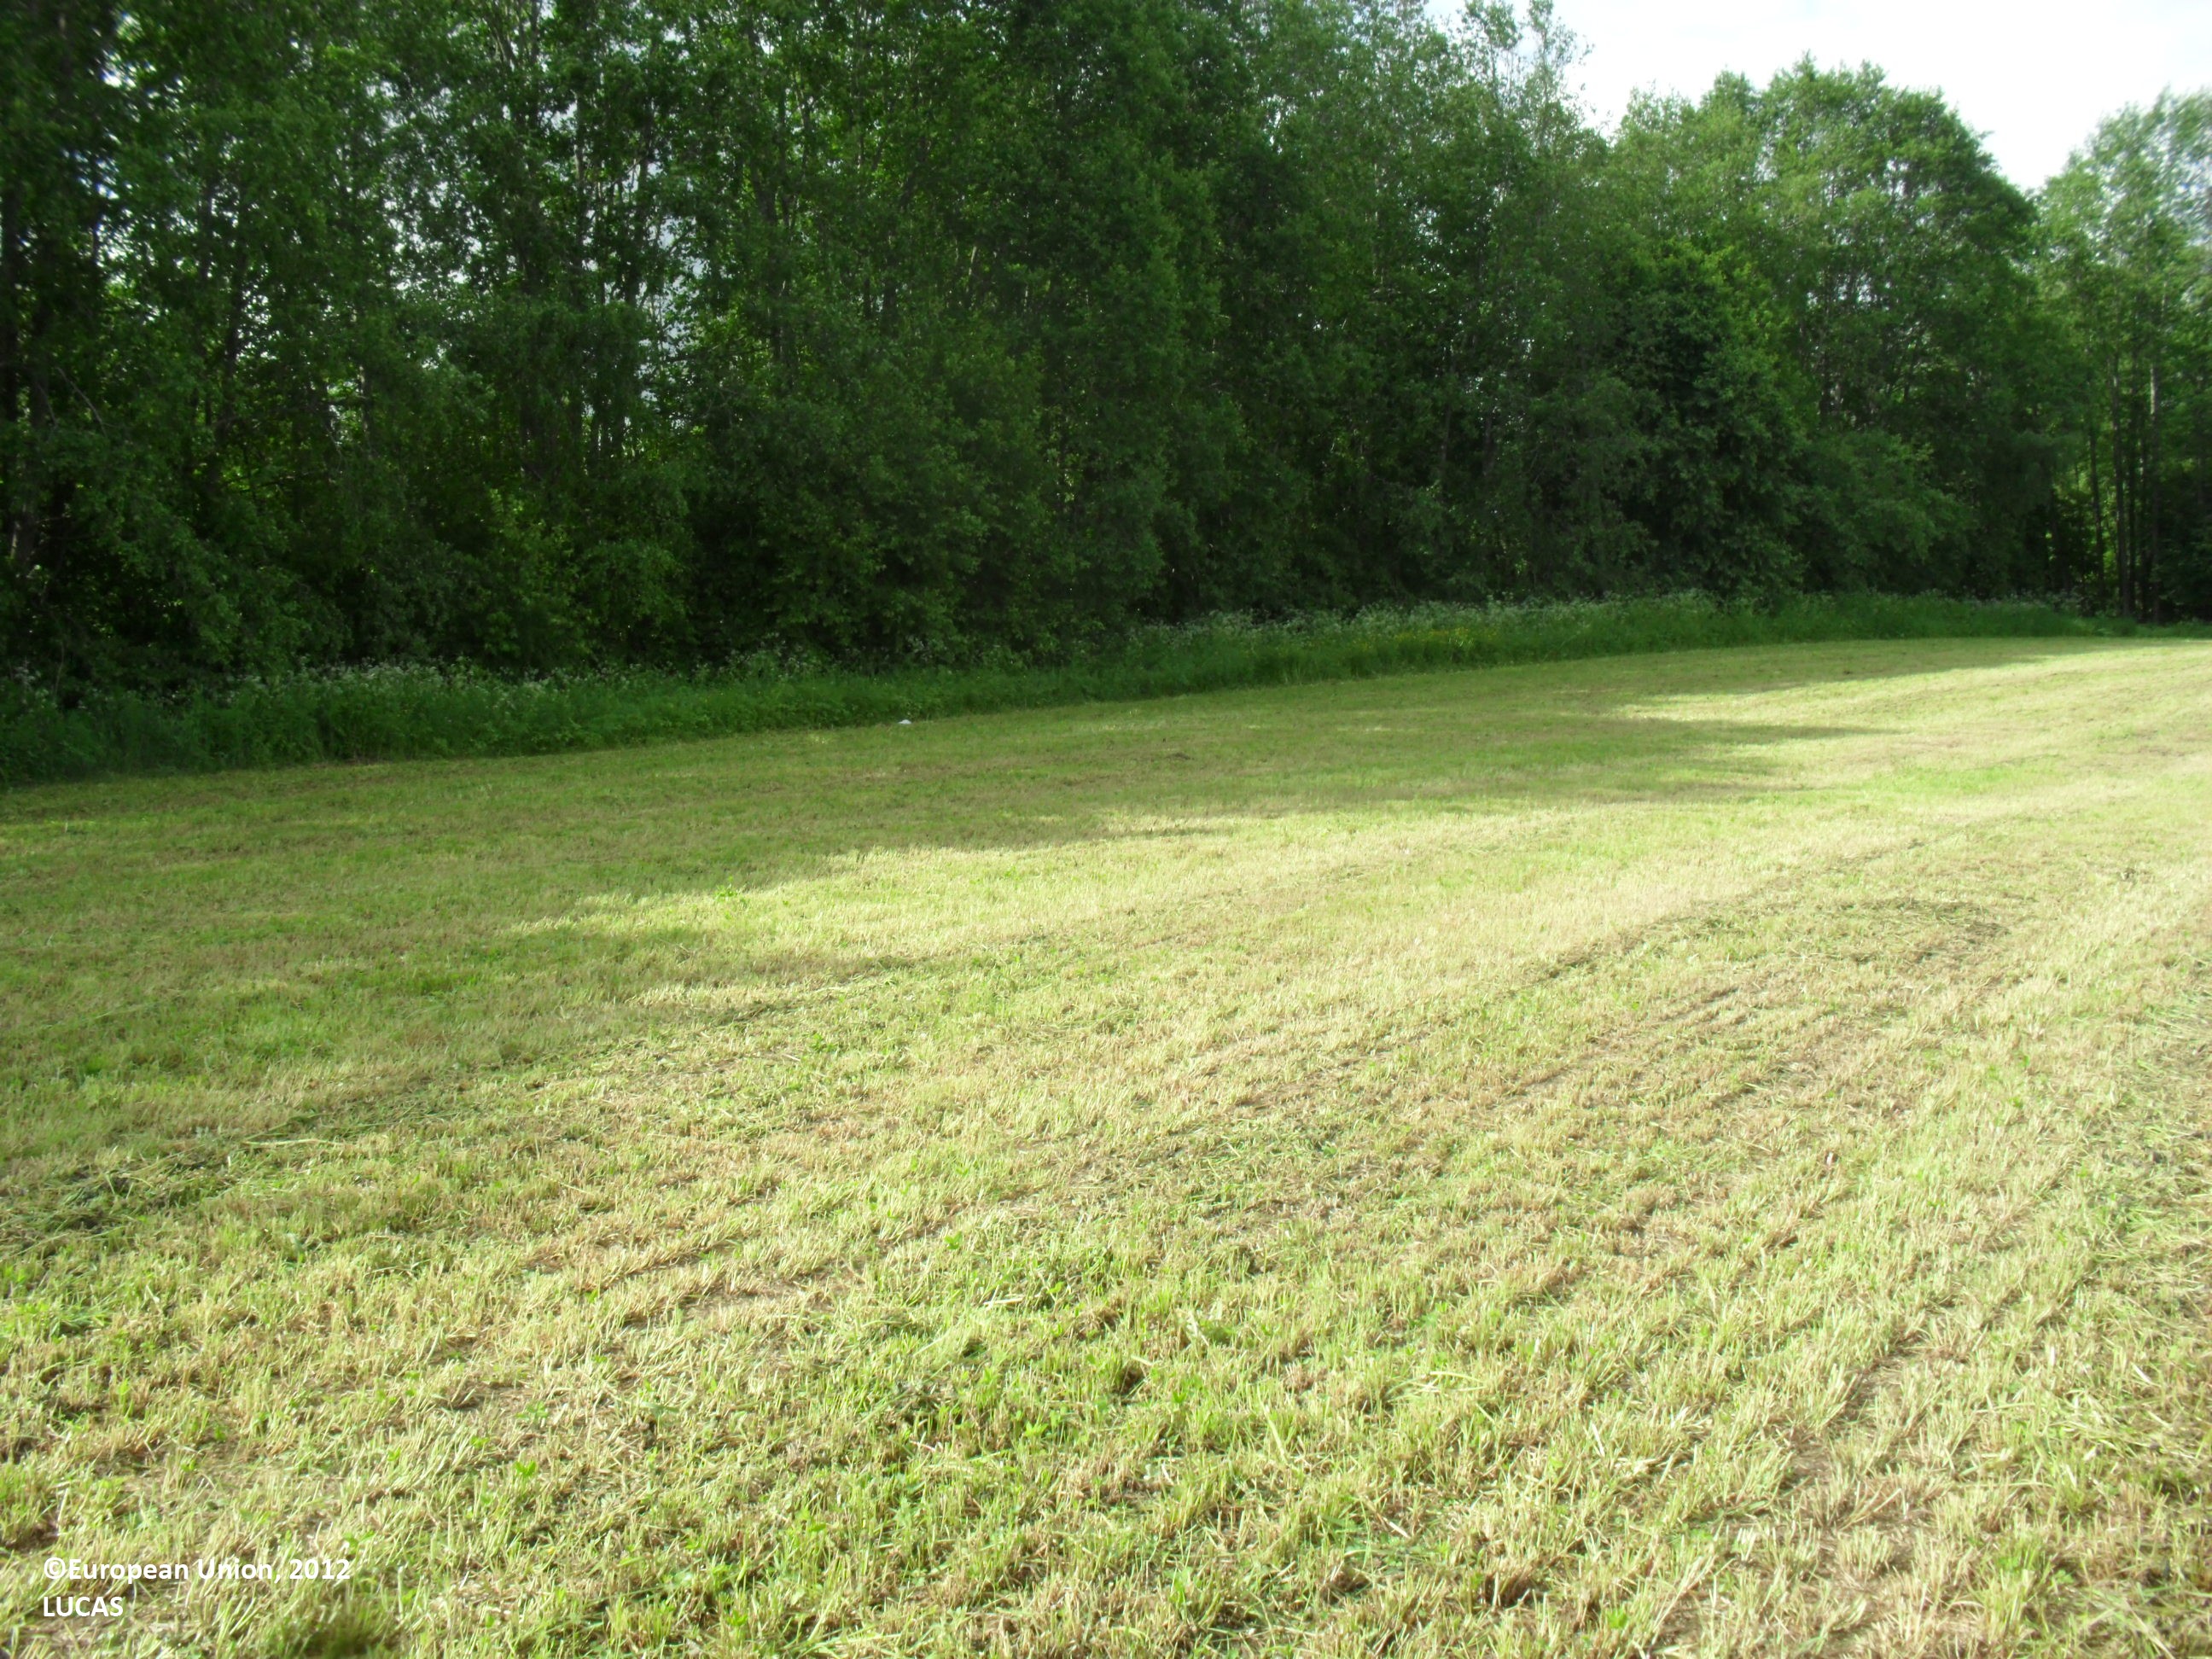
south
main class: Cropland
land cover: Temporary grasslands
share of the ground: 25 - 50 %
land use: Agriculture (excluding fallow land and kitchen gardens)
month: June
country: FI
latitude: 63.1274
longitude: 23.2081
